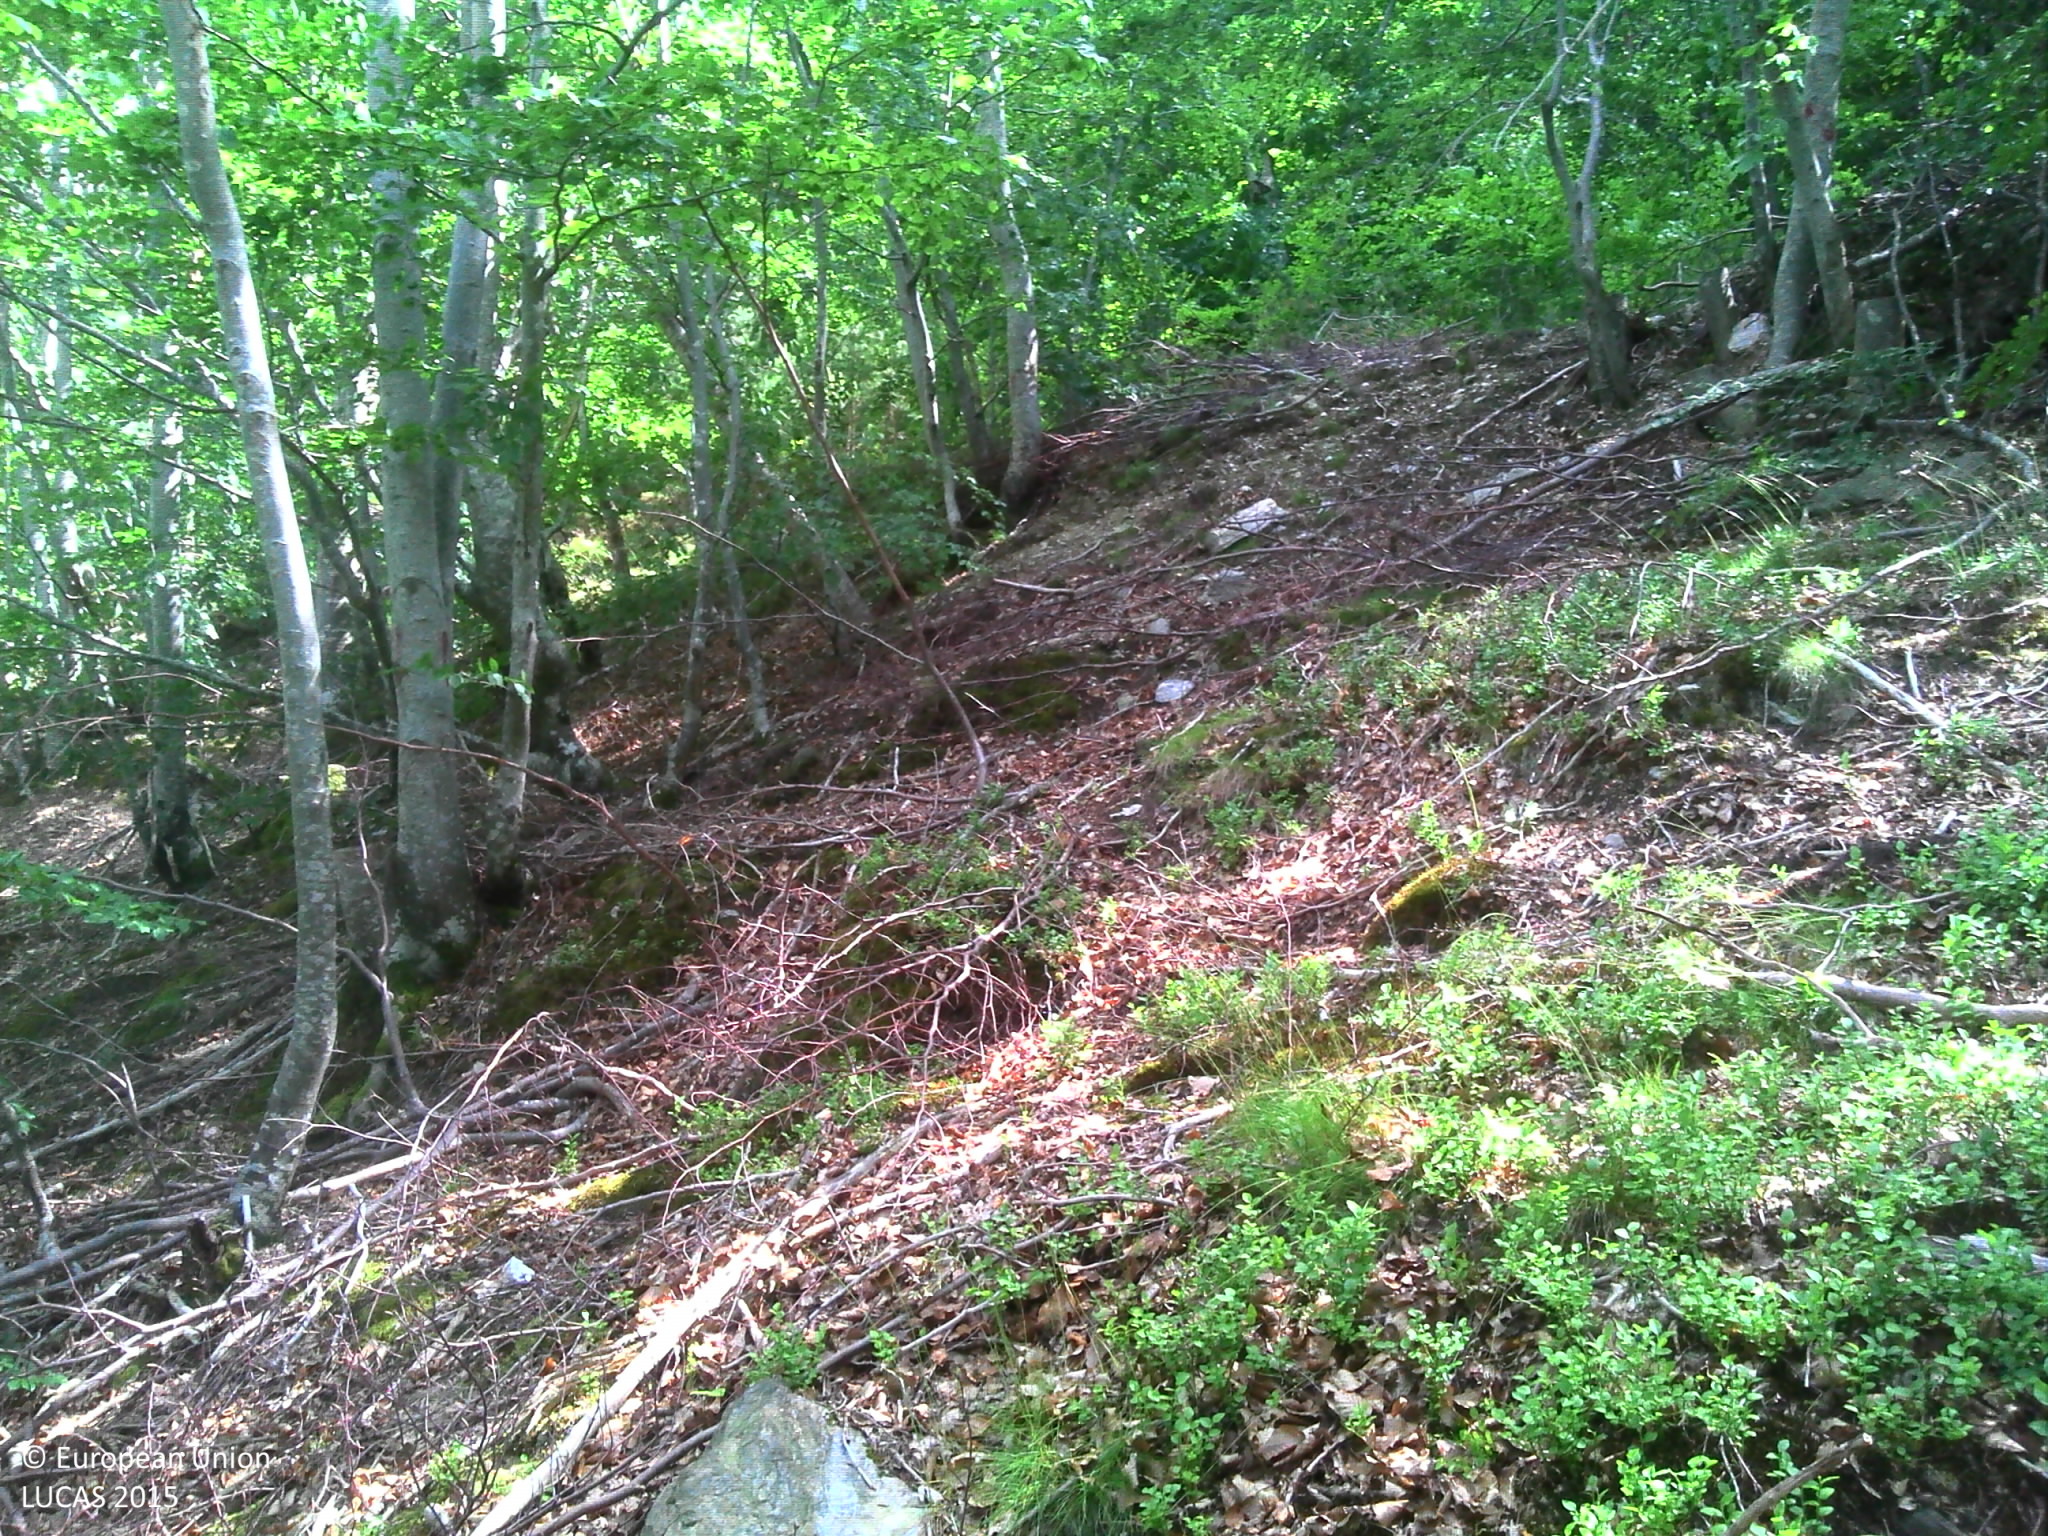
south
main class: Woodland
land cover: Other mixed woodland
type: mountainous beech forest
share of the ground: > 75 %
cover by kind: broadleaved forest trees 65 %, coniferous forest trees 25 %, herbaceous plants 10 %
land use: Forestry
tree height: > 5 m
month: June
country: FR
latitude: 44.5703
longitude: 3.9238
